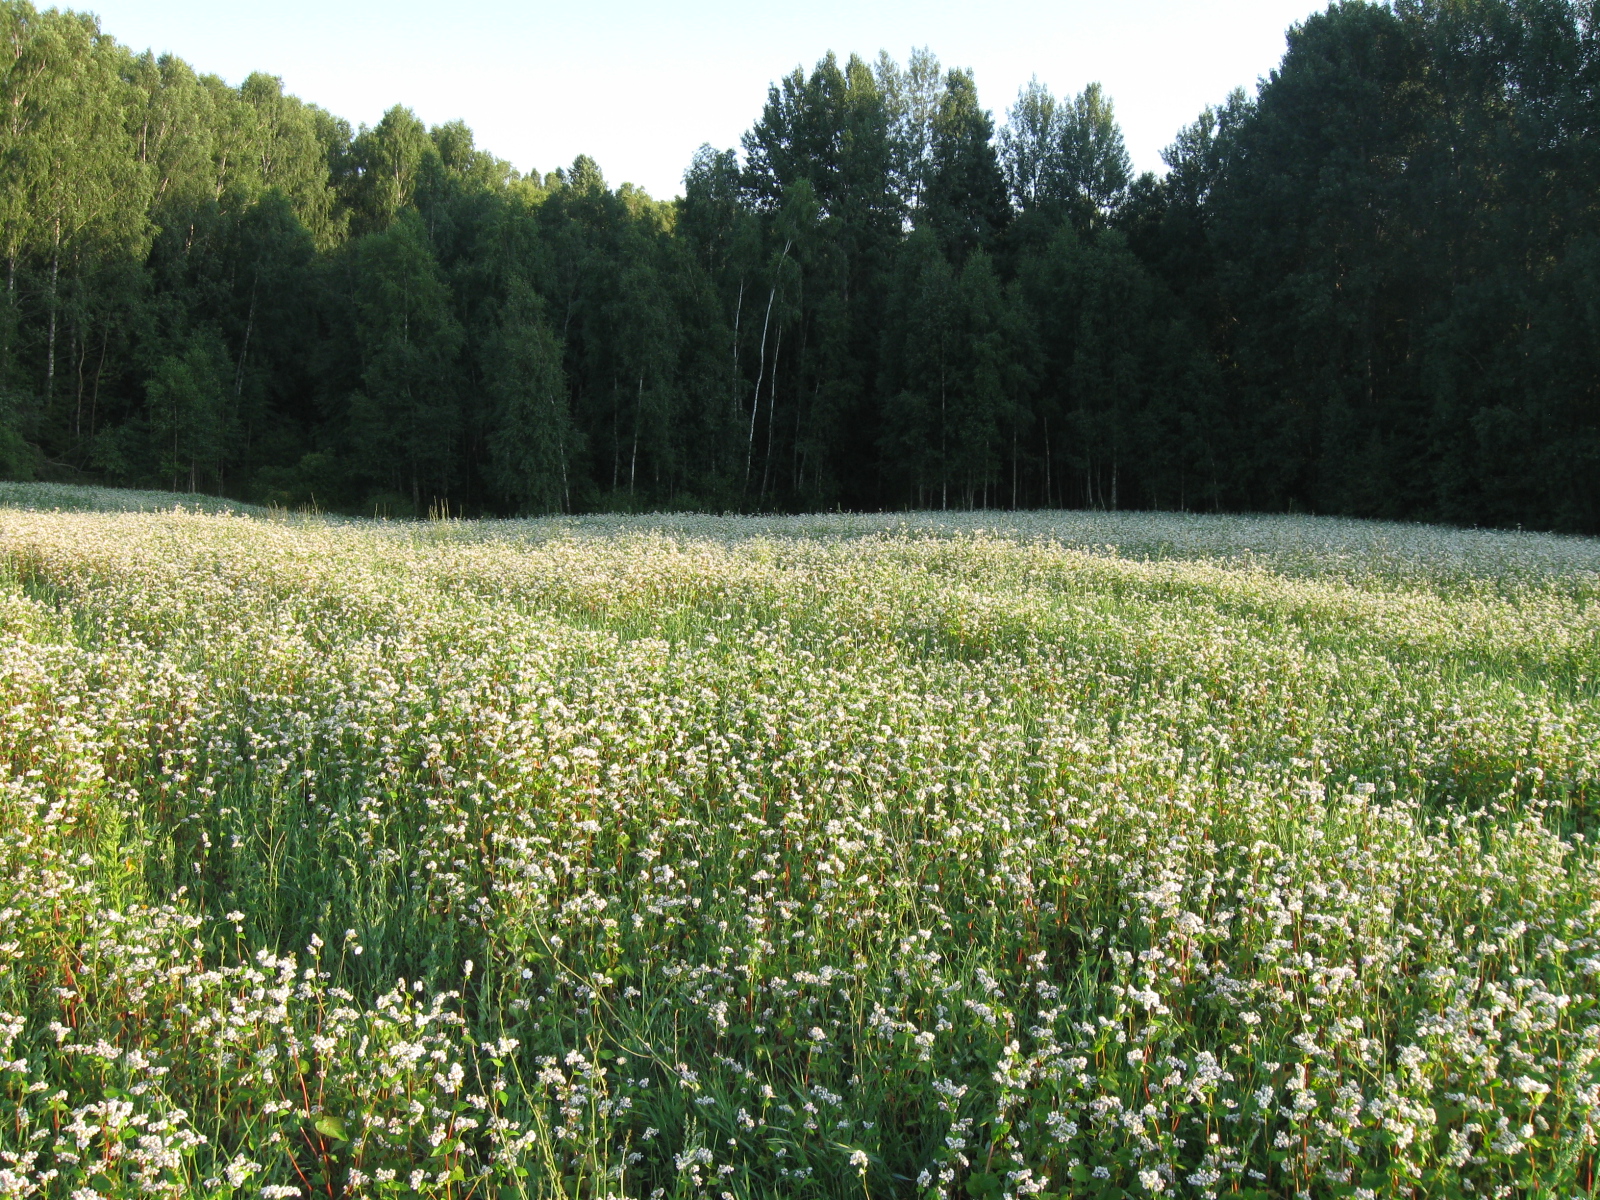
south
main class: Cropland
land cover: Other cereals
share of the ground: > 75 %
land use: Agriculture (excluding fallow land and kitchen gardens)
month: July
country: LT
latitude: 54.0746
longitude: 23.7352
